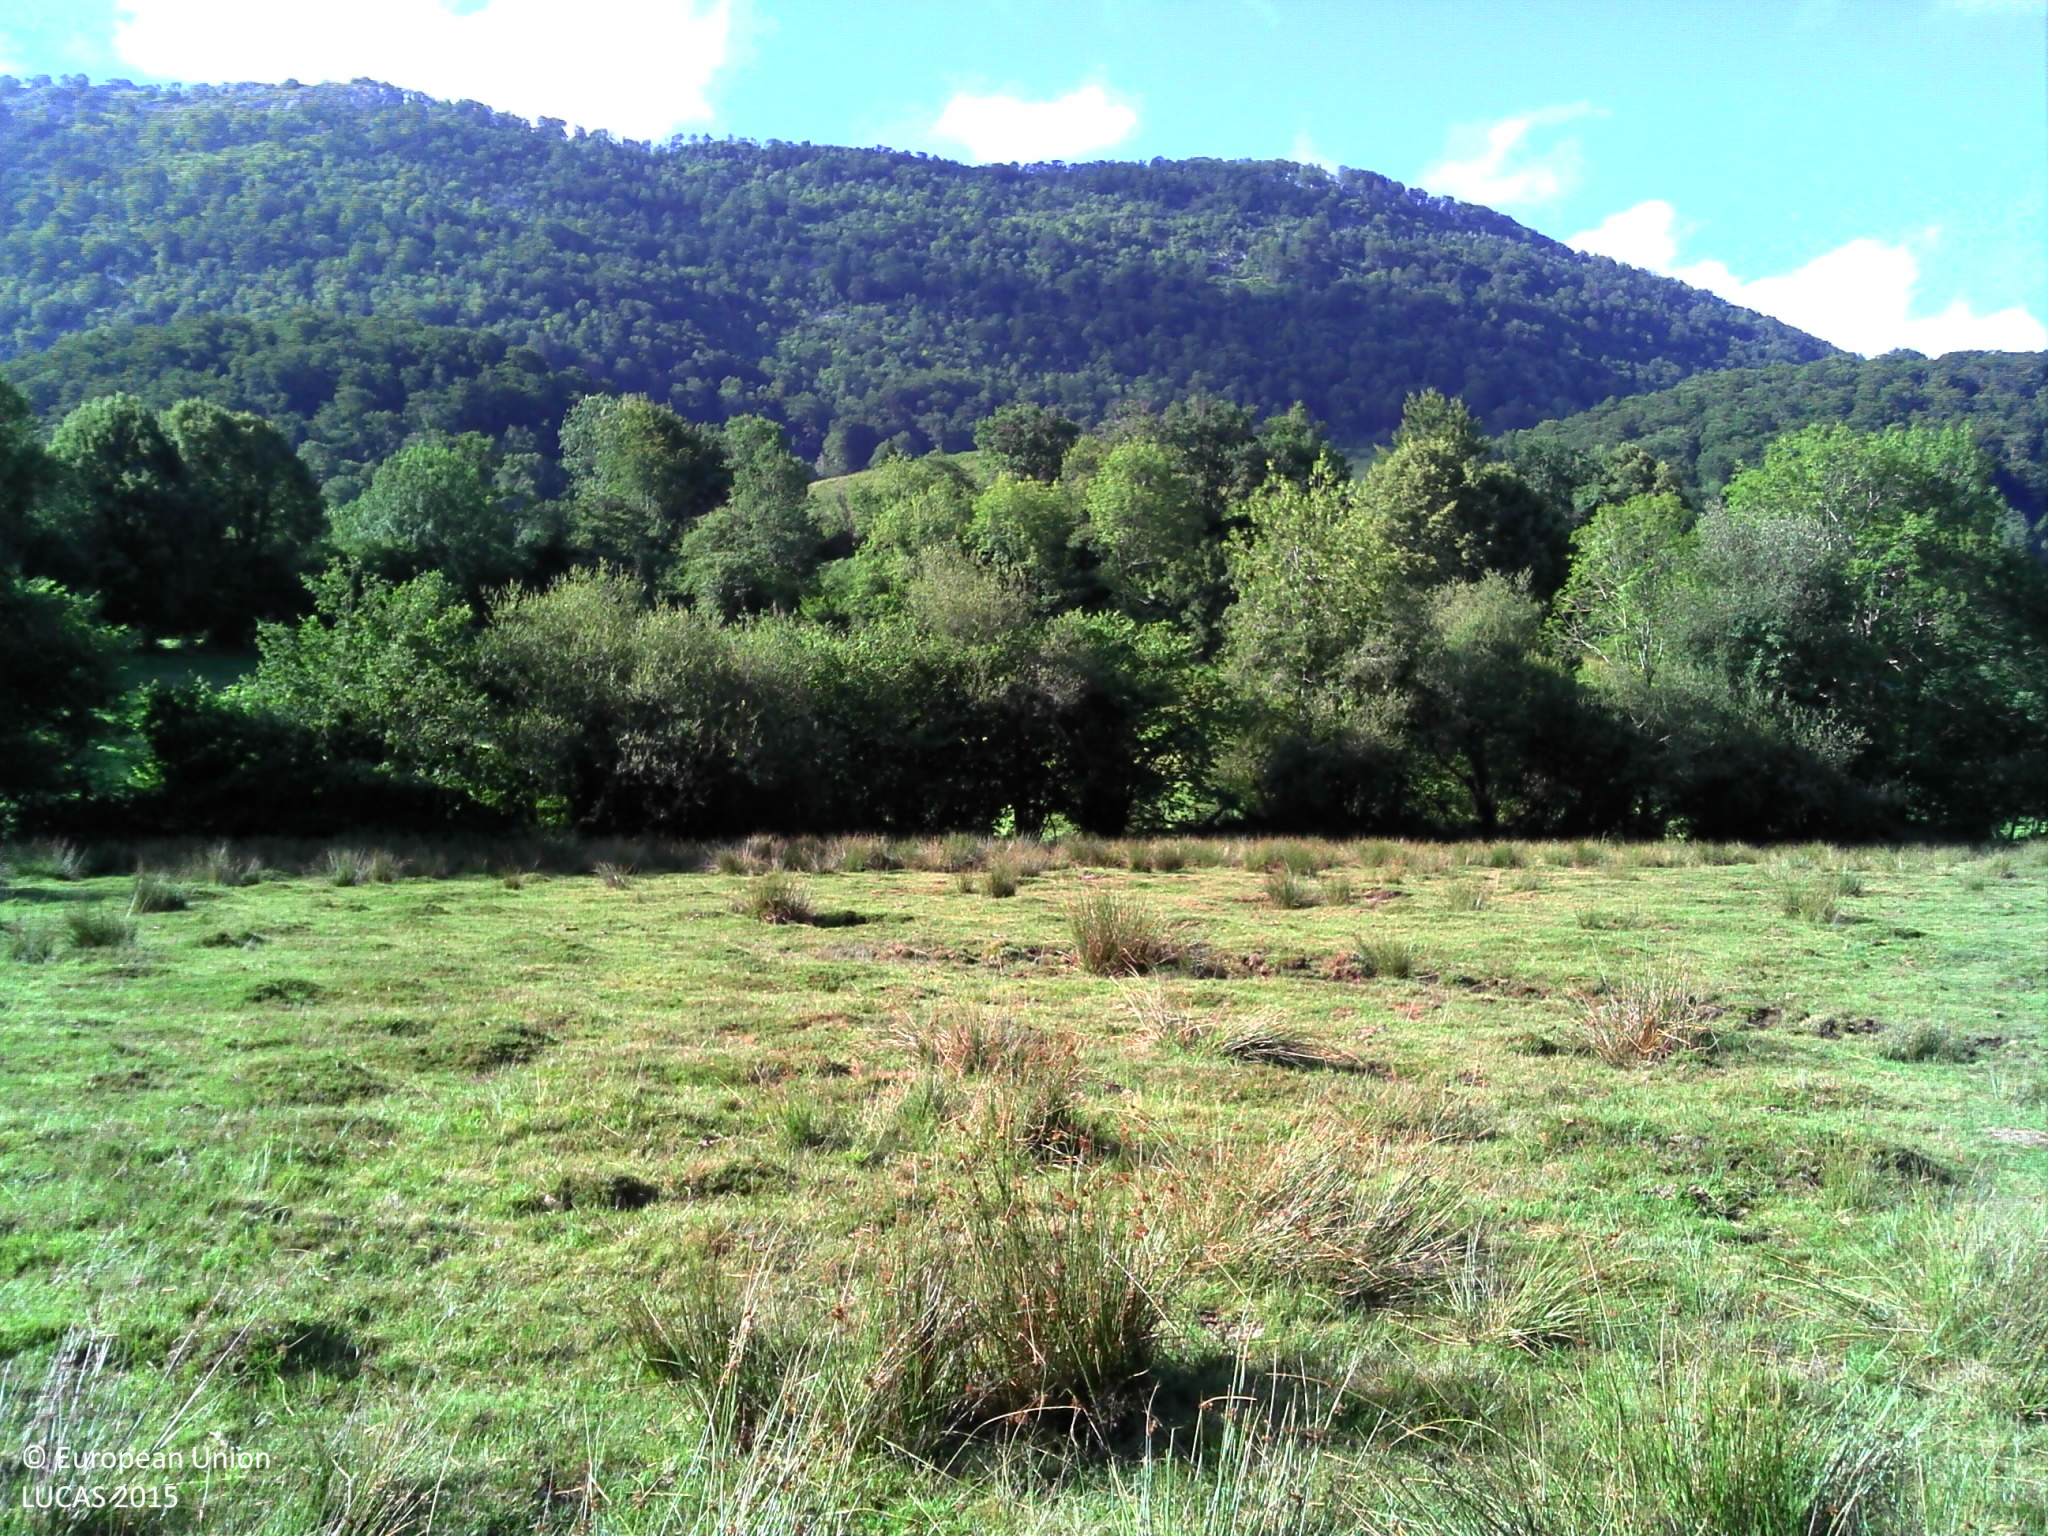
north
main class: Grassland
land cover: Grassland without tree/shrub cover
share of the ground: > 75 %
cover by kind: herbaceous plants 100 %
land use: Agriculture (excluding fallow land and kitchen gardens)
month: July
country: FR
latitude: 43.0650
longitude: -0.3815
